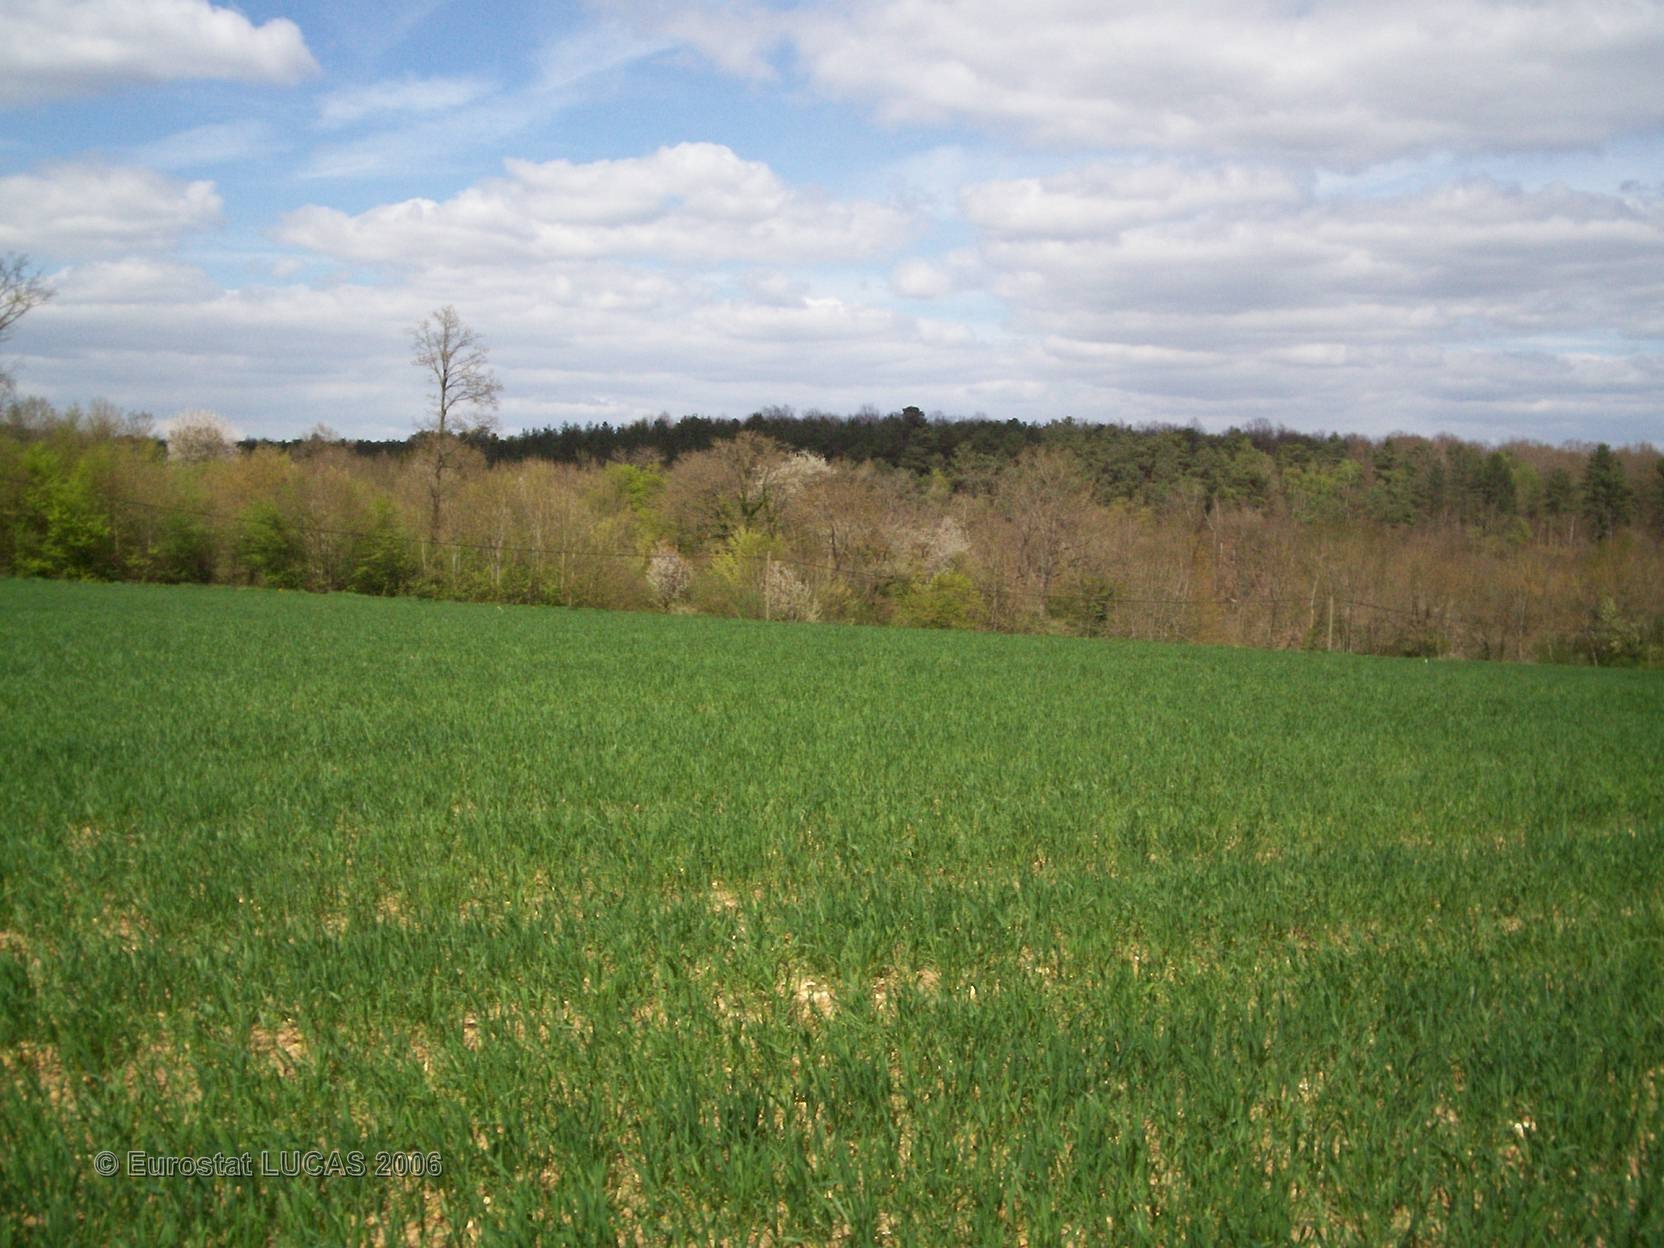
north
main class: Cropland
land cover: Common wheat
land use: Agriculture (excluding fallow land and kitchen gardens)
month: April
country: FR
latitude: 48.9438
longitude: 1.0358
